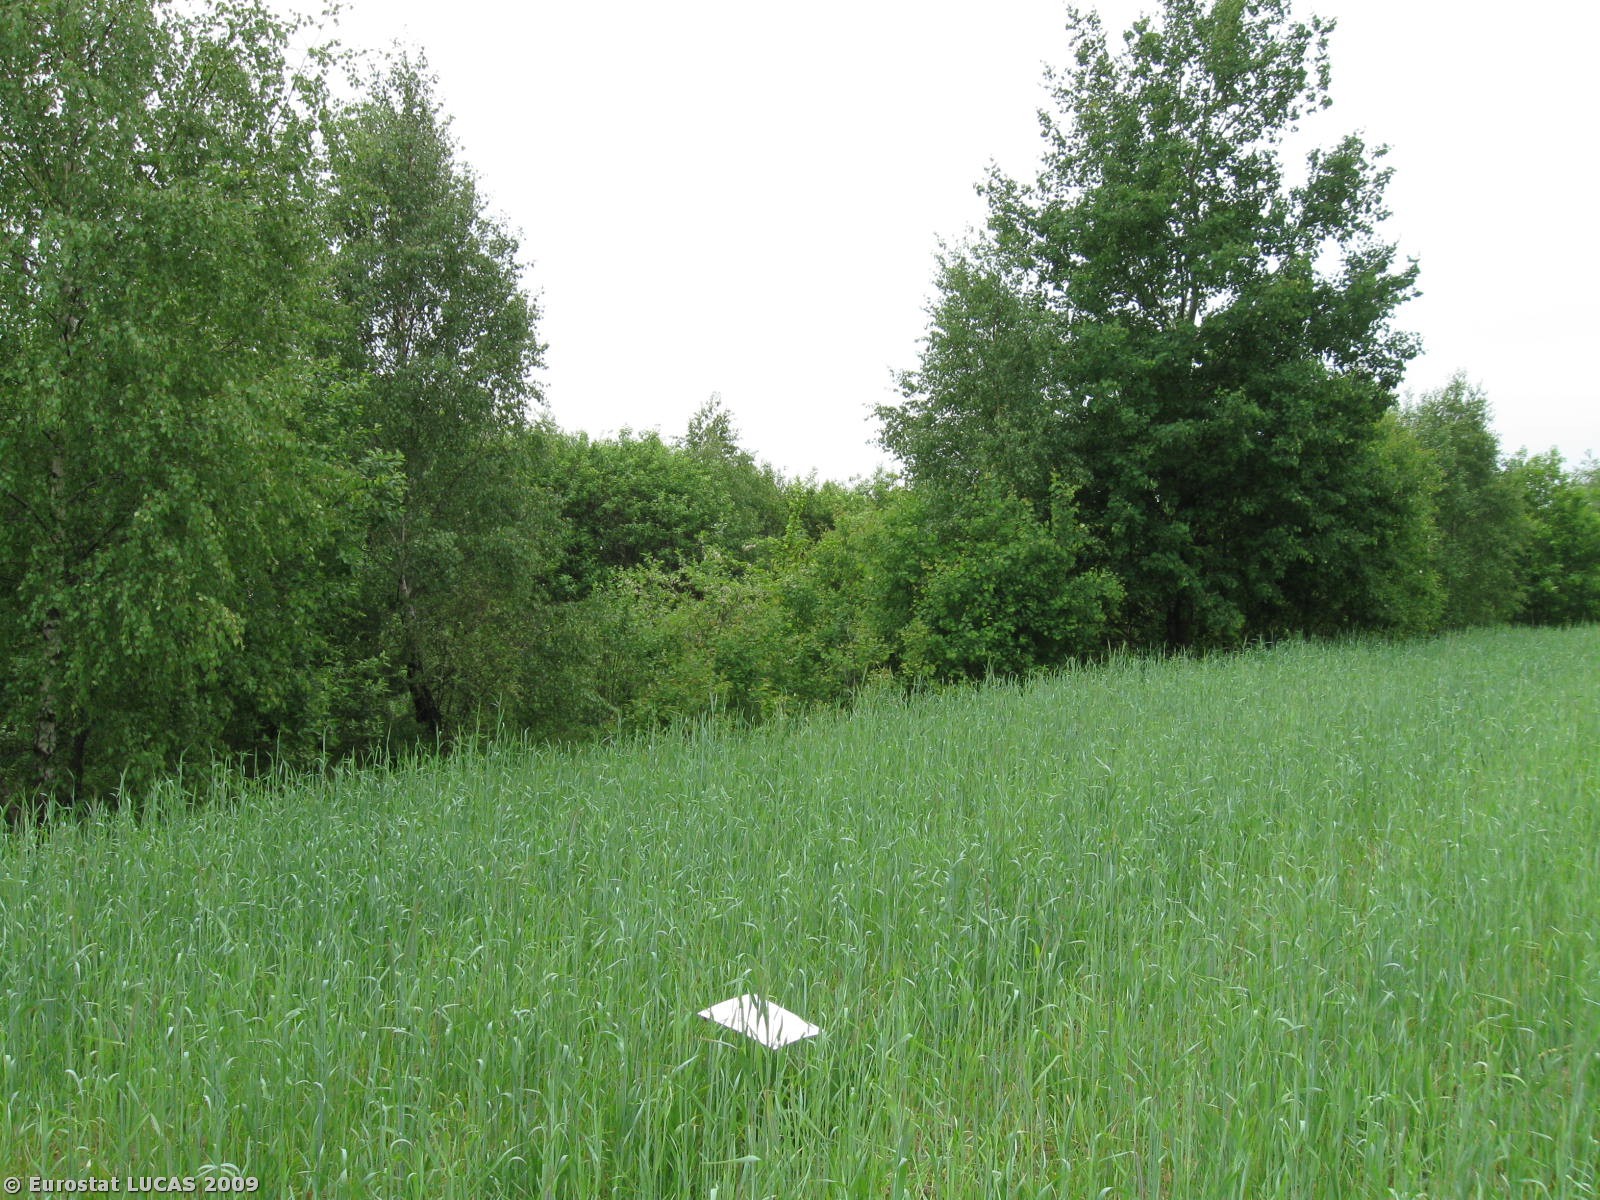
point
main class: Cropland
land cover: Rye
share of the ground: > 75 %
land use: Agriculture (excluding fallow land and kitchen gardens)
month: May
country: PL
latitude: 50.9697
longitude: 20.4762
